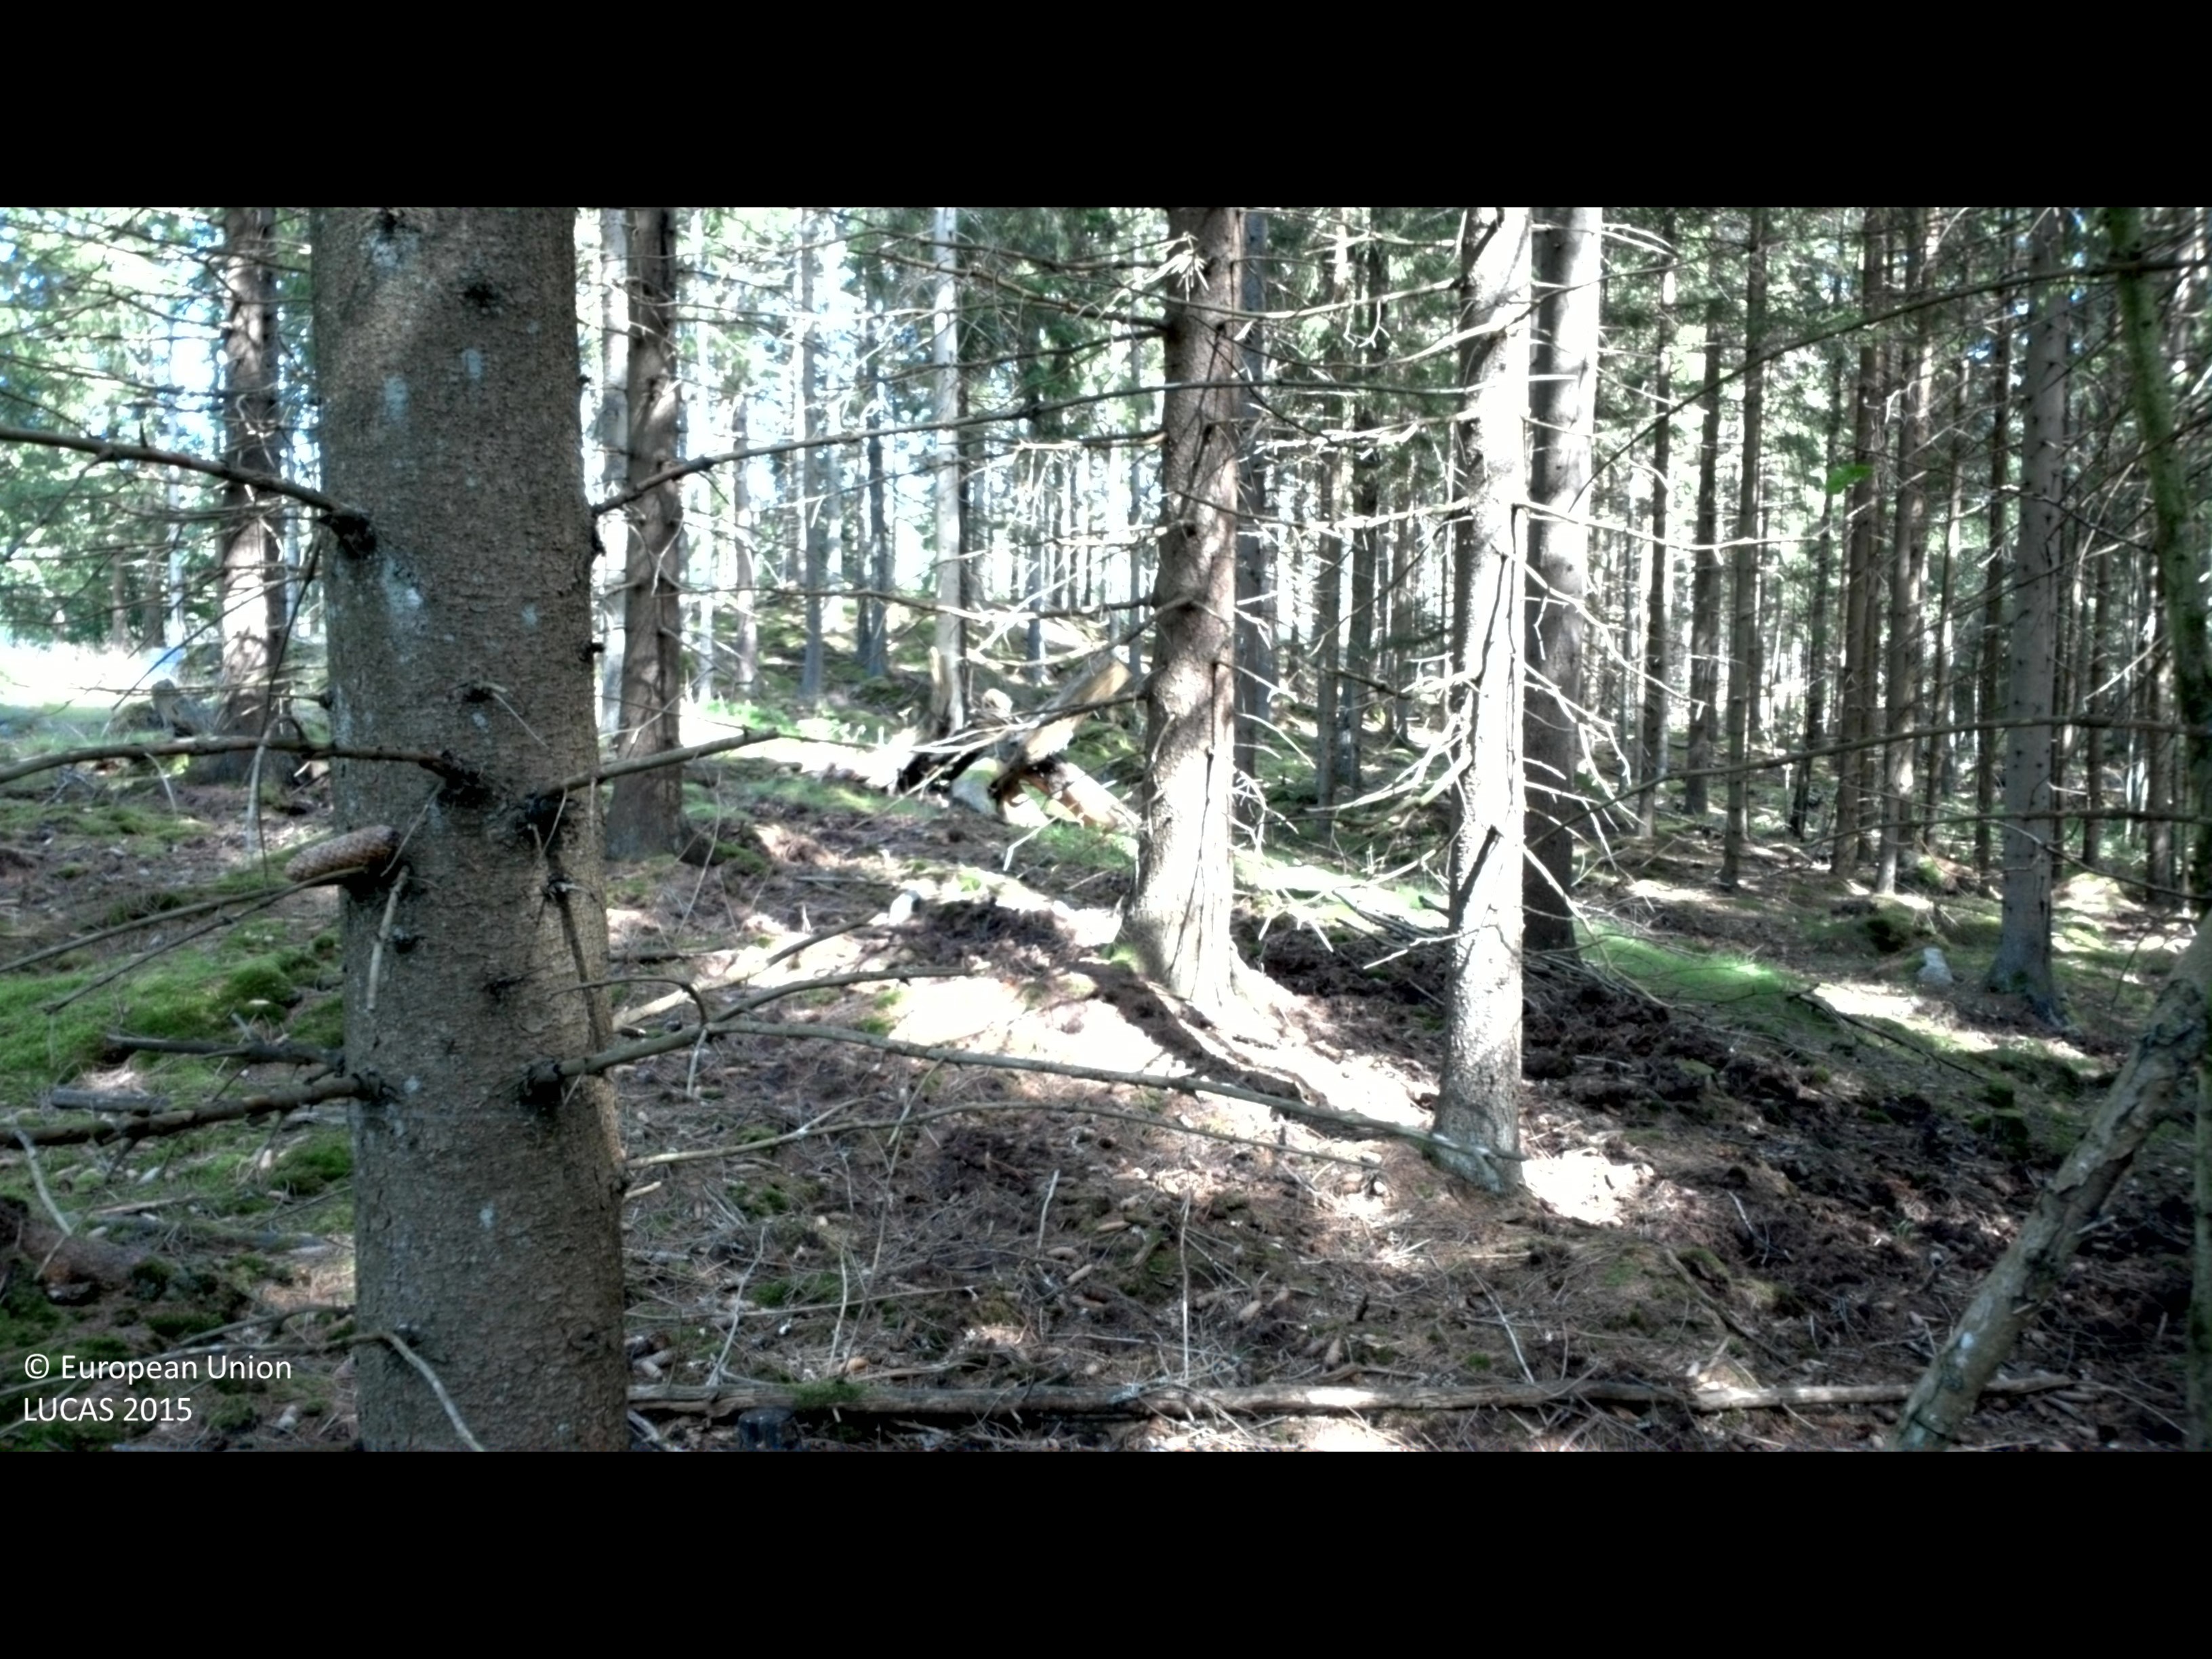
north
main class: Woodland
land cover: Spruce dominated coniferous woodland
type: boreal forest
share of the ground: 50 - 75 %
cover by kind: coniferous forest trees 70 %, lichens and mosses 25 %, herbaceous plants 5 %
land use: Forestry
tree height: > 5 m
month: August
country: SE
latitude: 56.3704
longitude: 14.7417
